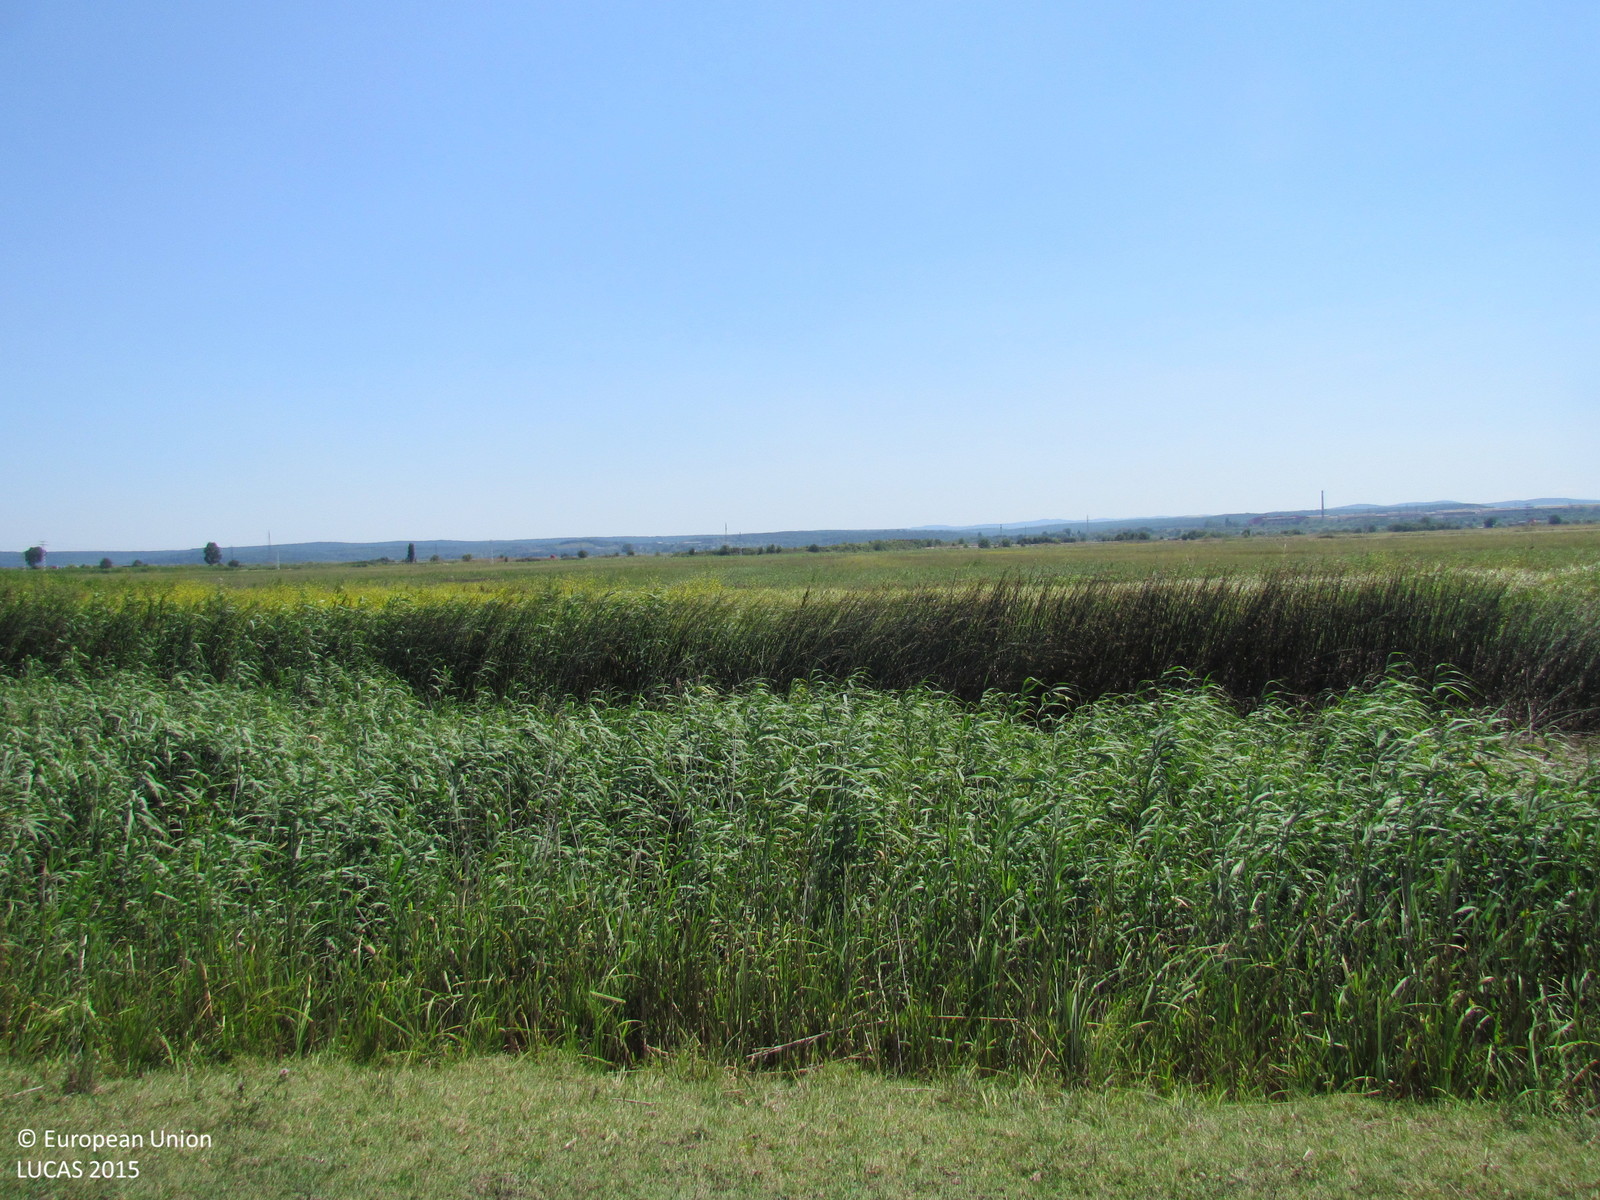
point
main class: Grassland
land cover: Spontaneously vegetated surfaces
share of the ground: > 75 %
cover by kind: herbaceous plants 100 %
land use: Fallow land
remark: Temporary flooded
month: July
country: BG
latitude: 42.4044
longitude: 27.3035
